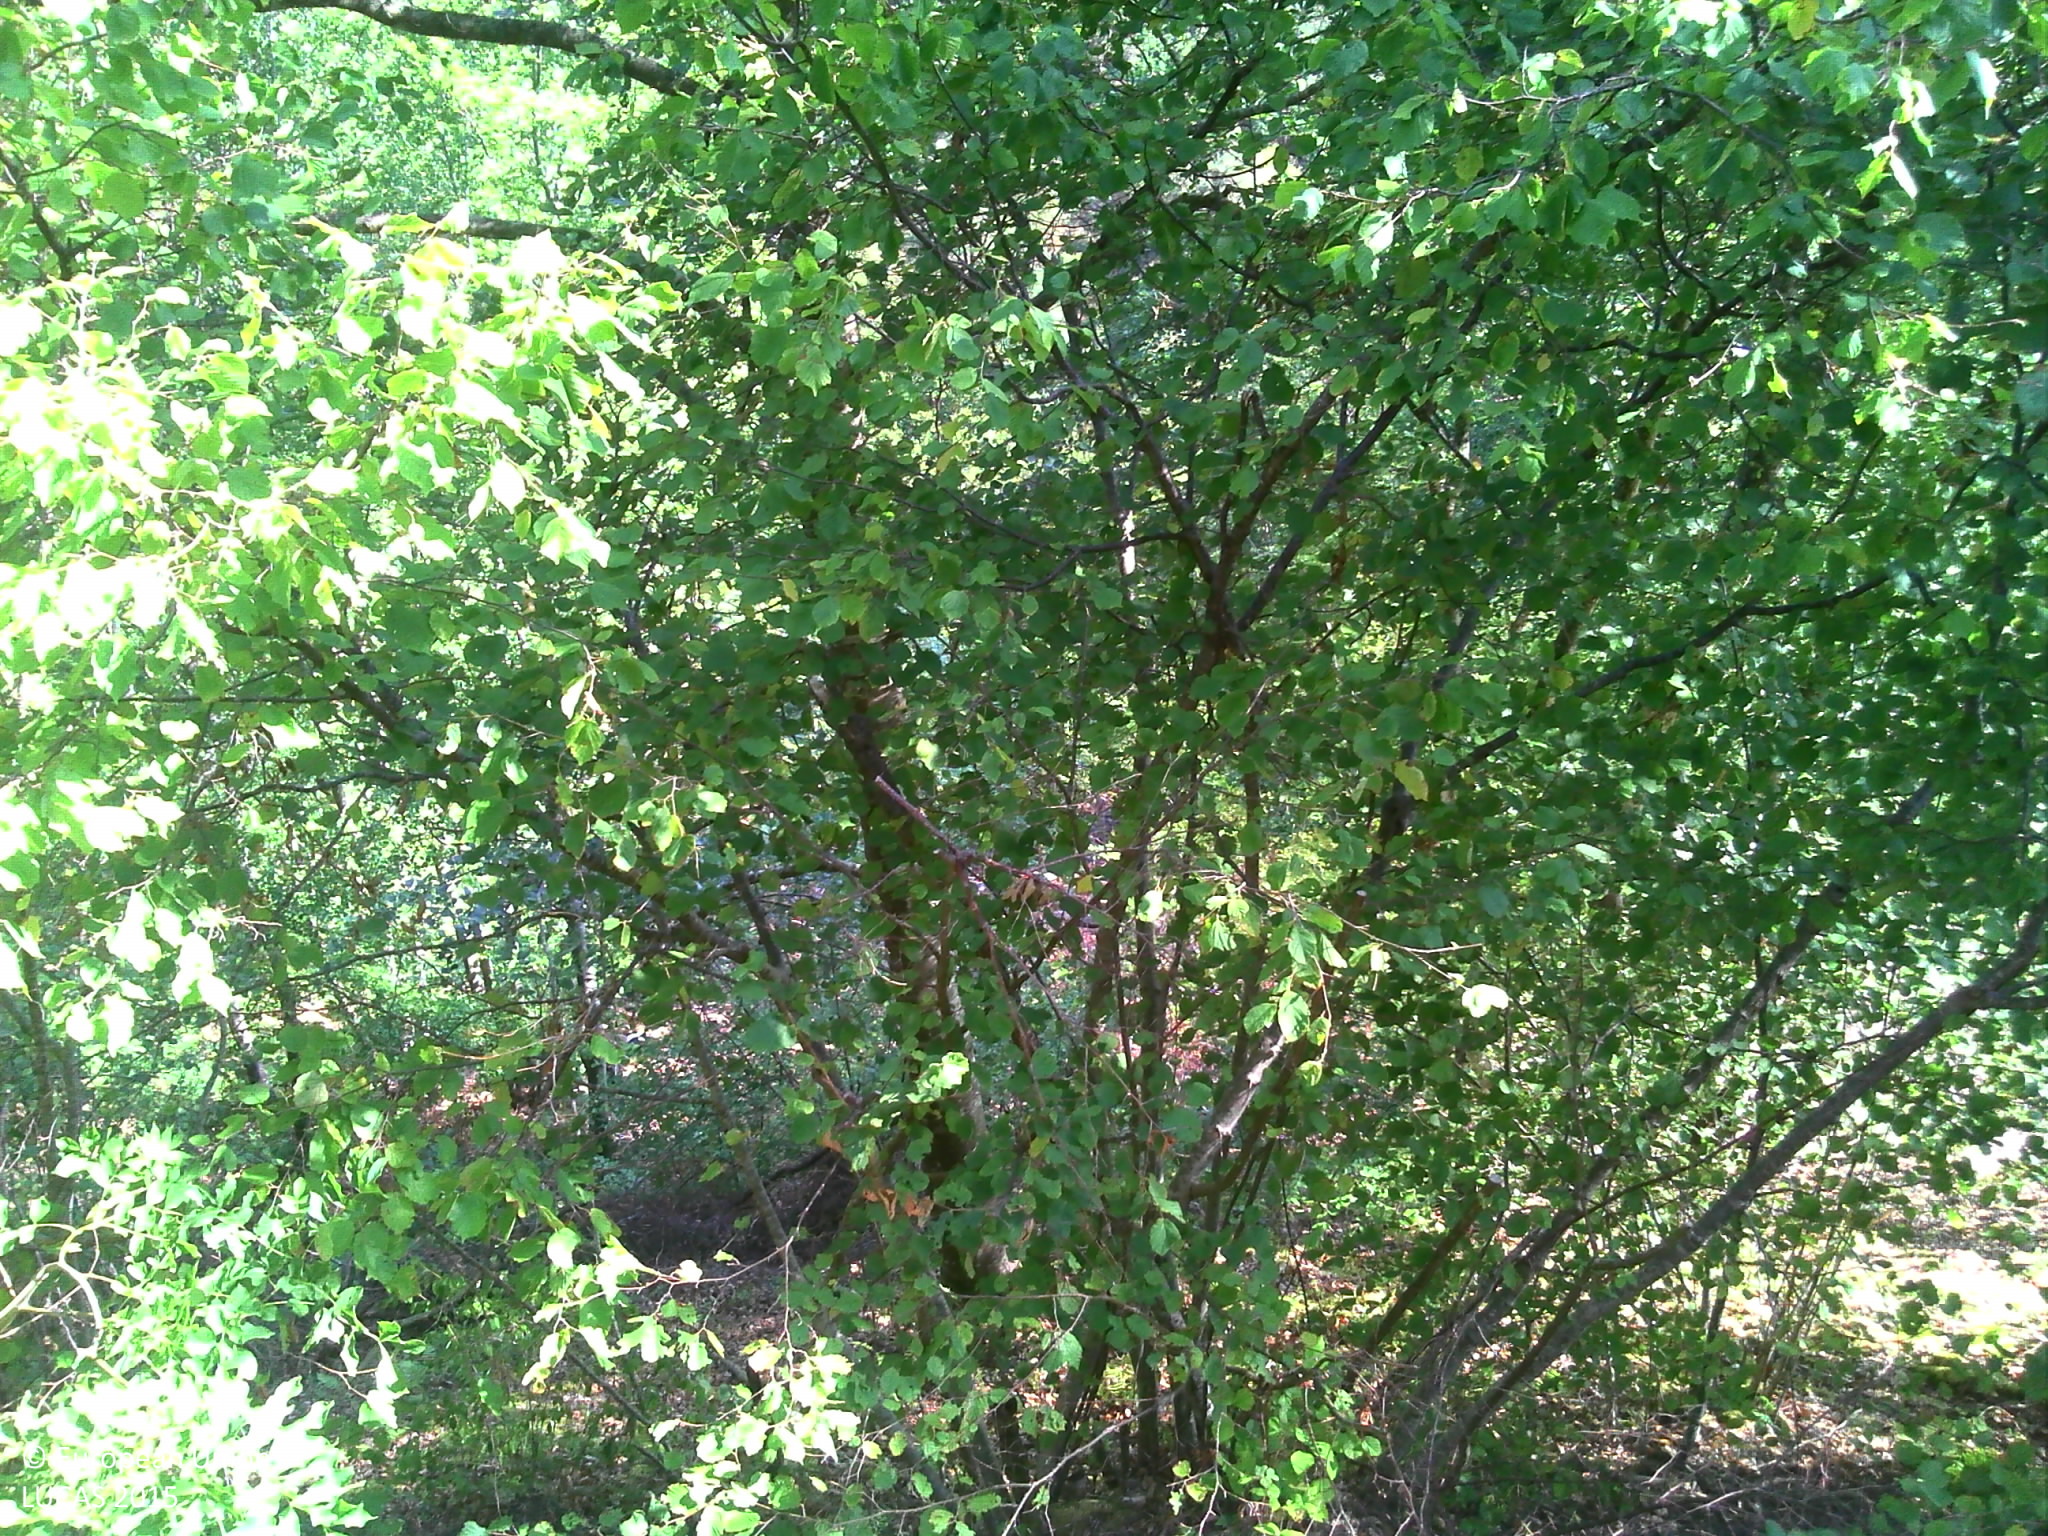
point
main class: Woodland
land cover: Broadleaved woodland
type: acidophilous oak and oak-birch forest
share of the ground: > 75 %
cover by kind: broadleaved forest trees 80 %, coniferous forest trees 10 %, shrubs 10 %
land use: Forestry
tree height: > 5 m
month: August
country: FR
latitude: 45.2168
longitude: 3.8530
